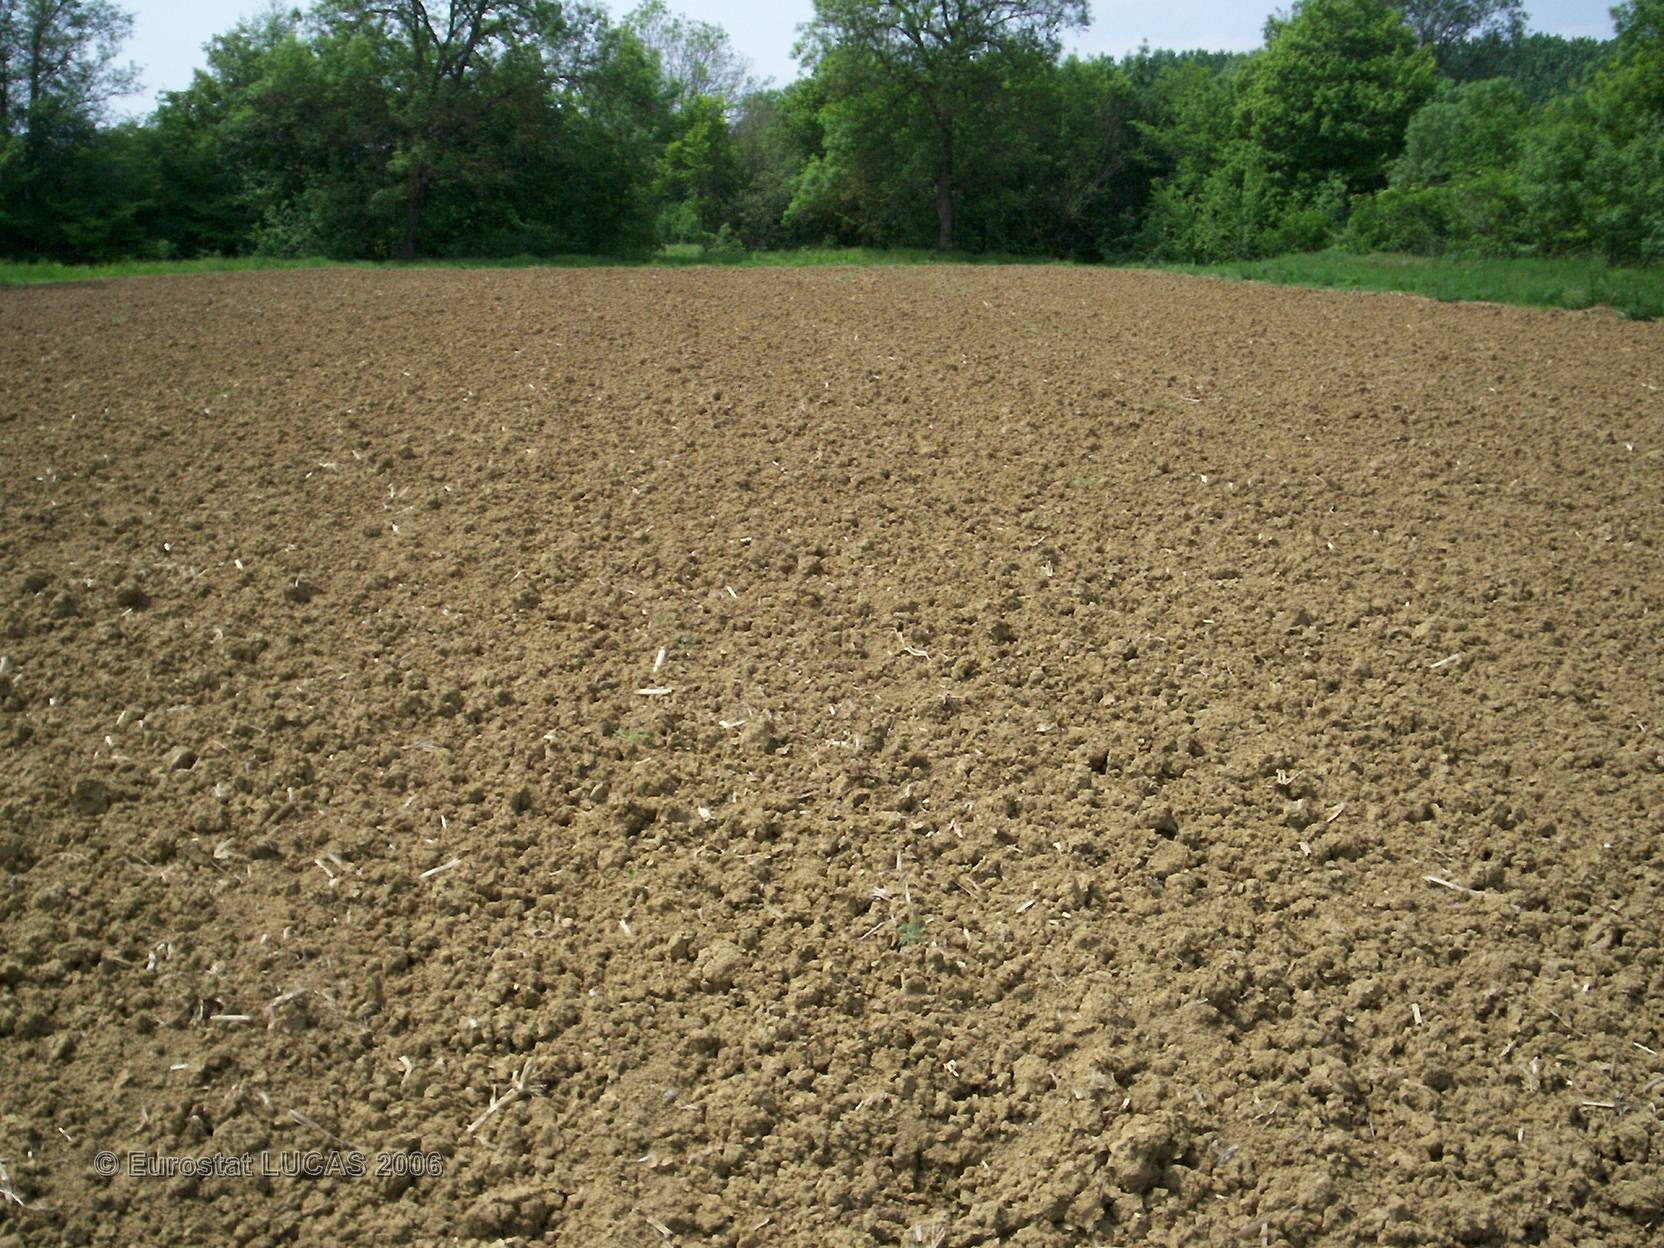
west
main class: Cropland
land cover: Maize
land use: Agriculture (excluding fallow land and kitchen gardens)
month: June
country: FR
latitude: 43.9974
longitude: 0.2289
